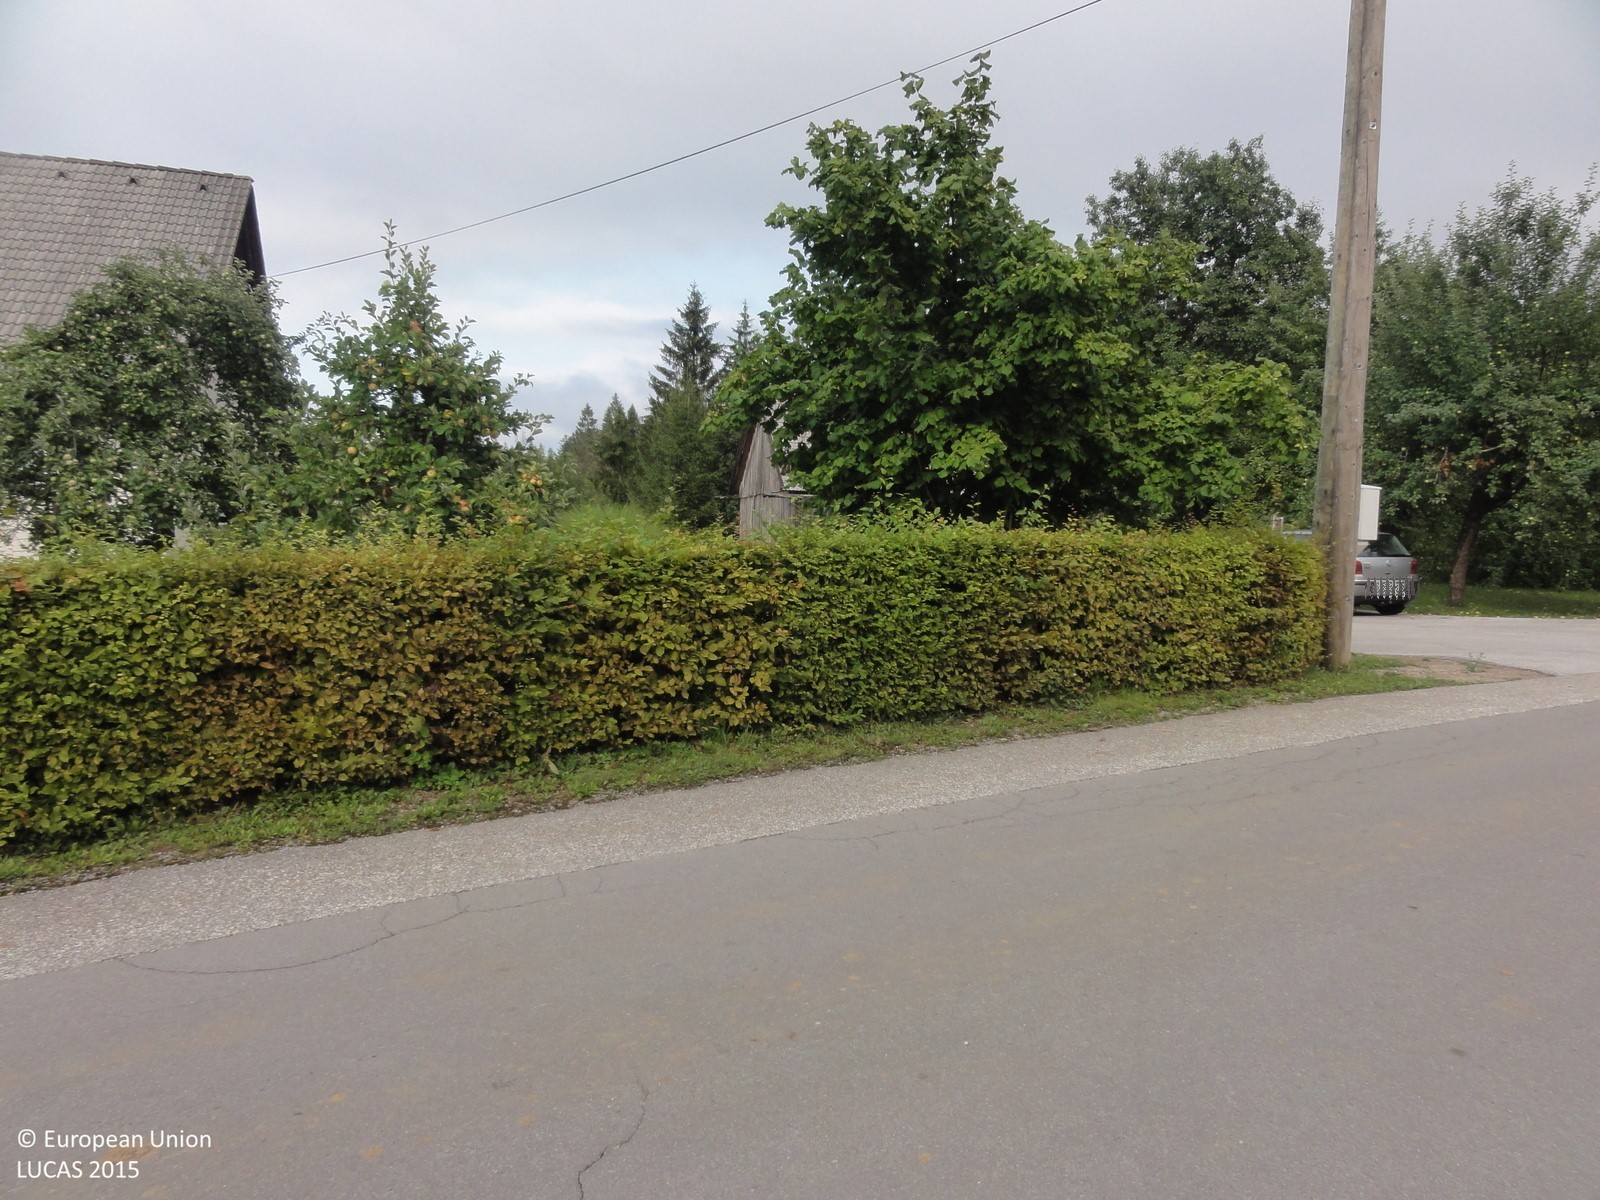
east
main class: Artificial land
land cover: Non built-up area features
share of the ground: > 75 %
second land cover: Spontaneously vegetated surfaces
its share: > 75 %
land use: Residential
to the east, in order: Artificial constructions in urban areas; Spontaneously vegetated surfaces; Artificial constructions in urban areas; Shrubland with sparse tree cover; Spruce dominated mixed woodland; Shruby margins; Grass margins; Fences; Paved roads, cycling and walking lanes; Other bare soil; Fences; Tracks; Shruby margins; Spruce dominated coniferous woodland; Spruce dominated mixed woodland
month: July
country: SI
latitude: 45.6859
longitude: 14.7595
